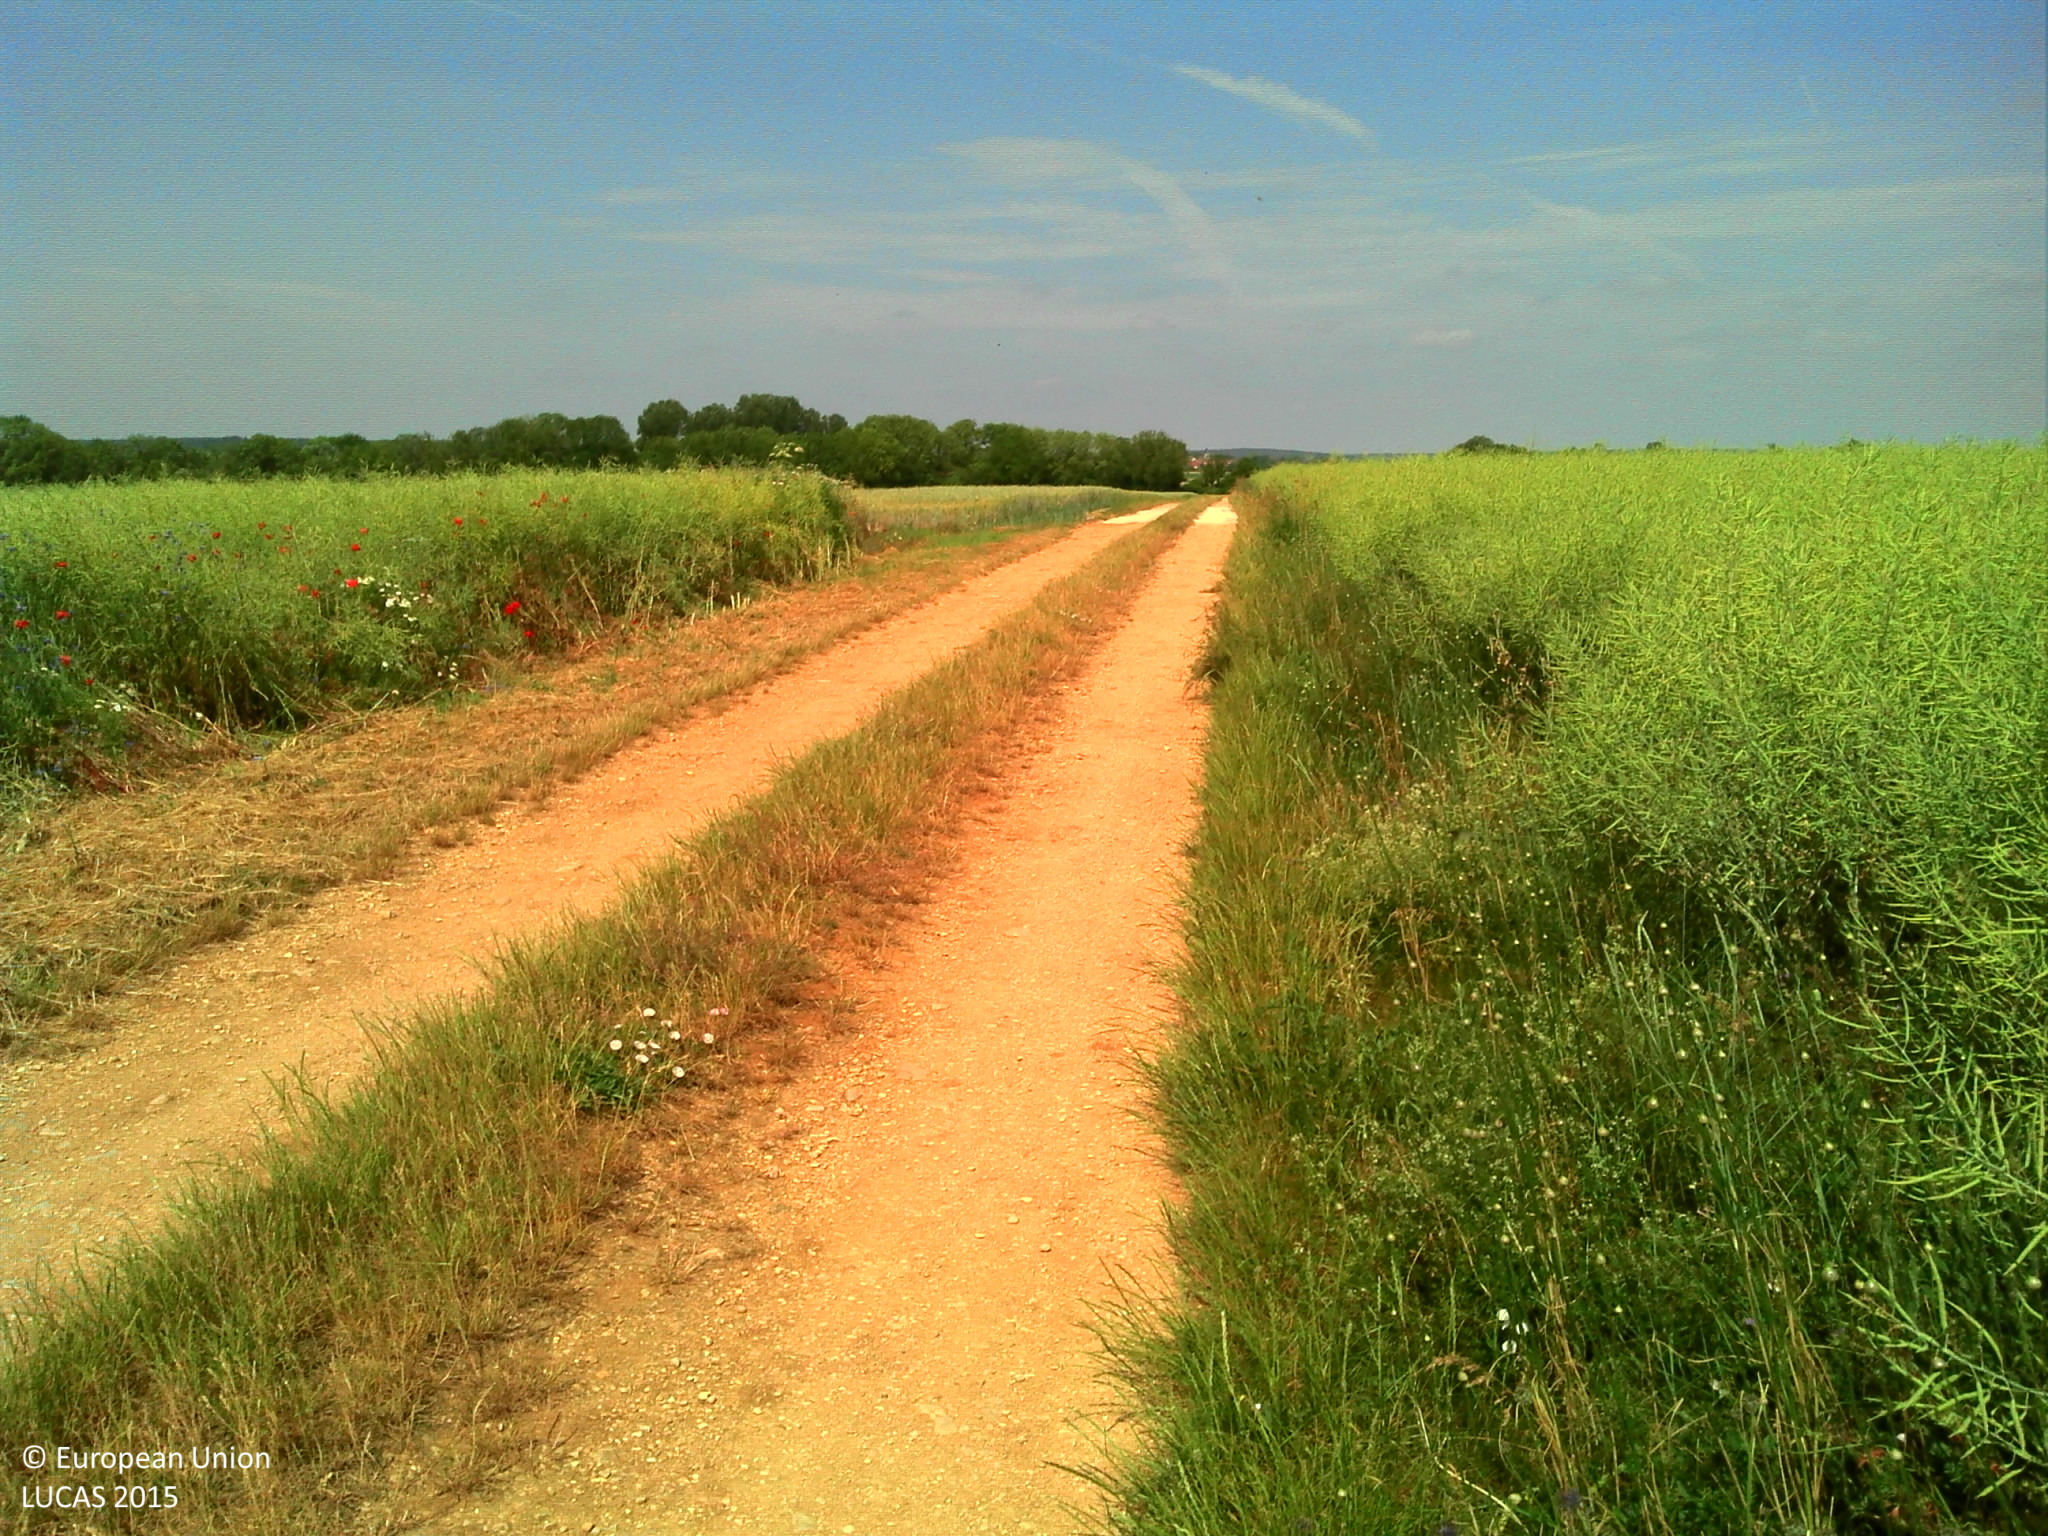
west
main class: Cropland
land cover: Rape and turnip rape
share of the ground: > 75 %
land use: Agriculture (excluding fallow land and kitchen gardens)
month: June
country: FR
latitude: 47.5064
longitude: 5.2075
